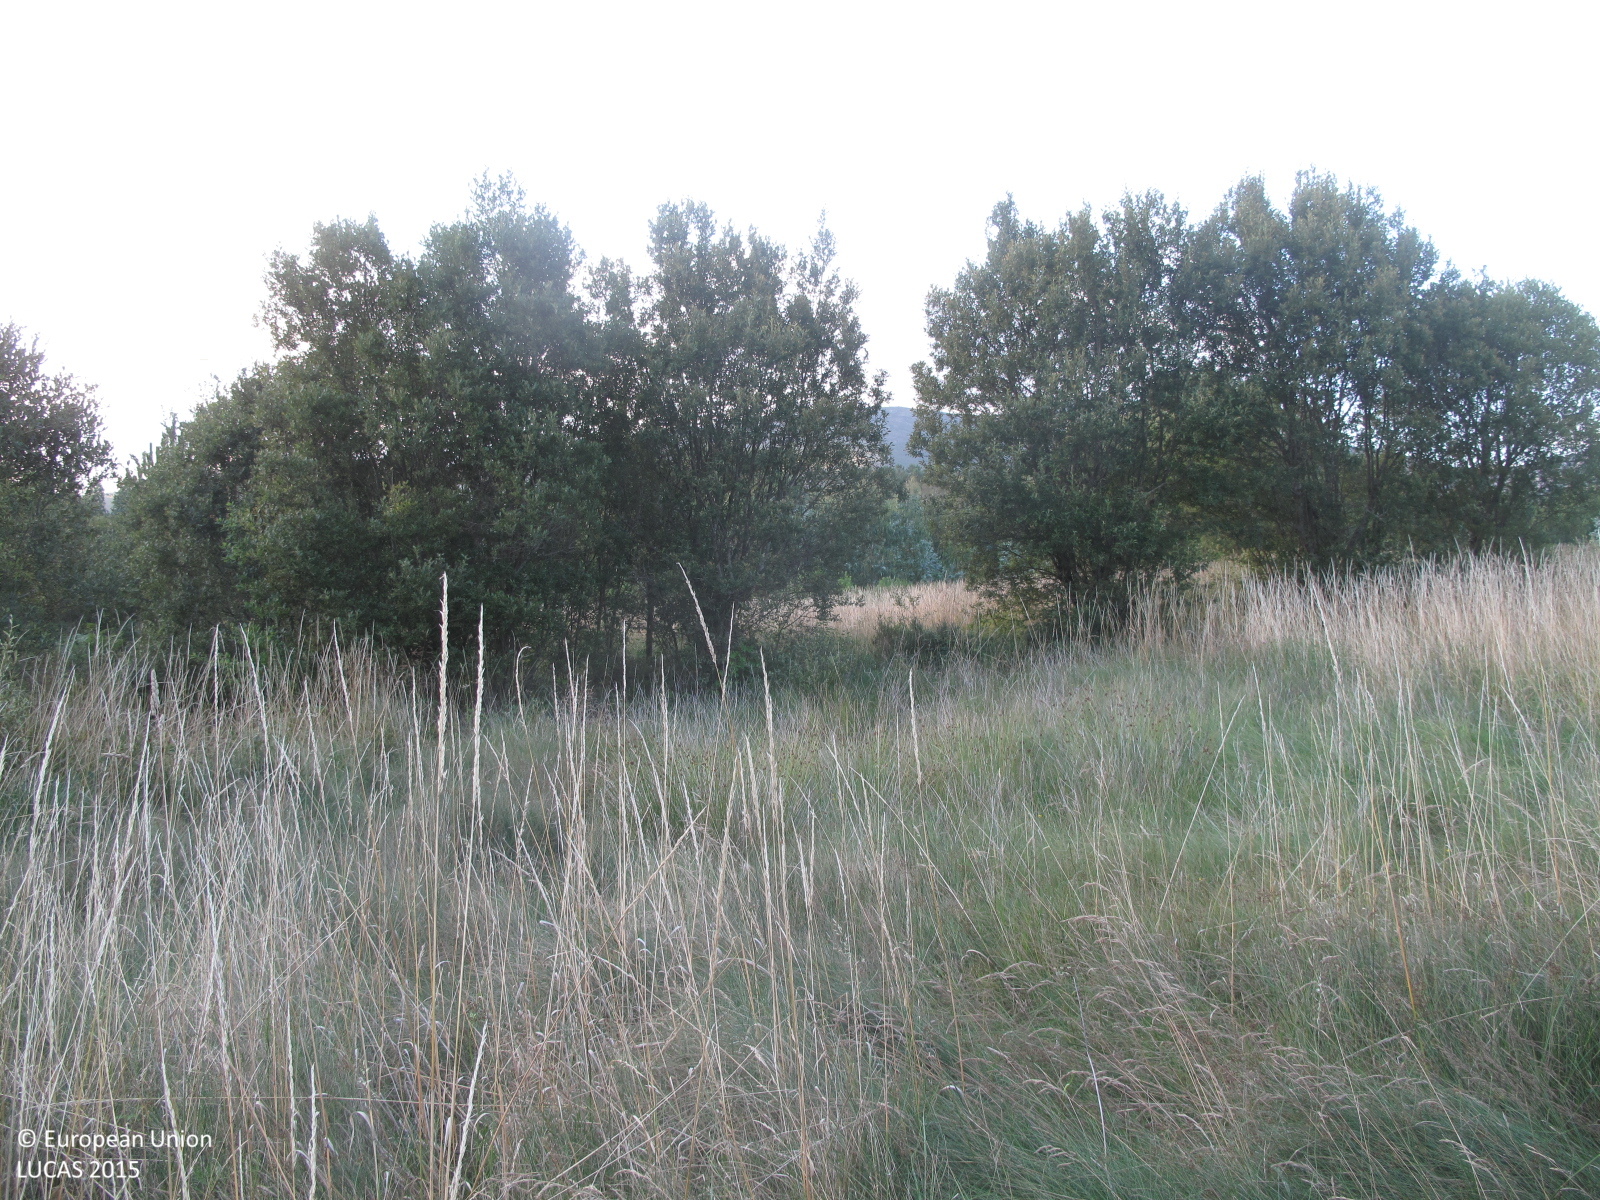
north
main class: Woodland
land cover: Pine dominated mixed woodland
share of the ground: 10 - 25 %
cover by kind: herbaceous plants 60 %, shrubs 20 %, coniferous forest trees 15 %, broadleaved forest trees 5 %
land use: Semi-natural and natural areas not in use
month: July
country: ES
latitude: 42.8952
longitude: -9.0664
